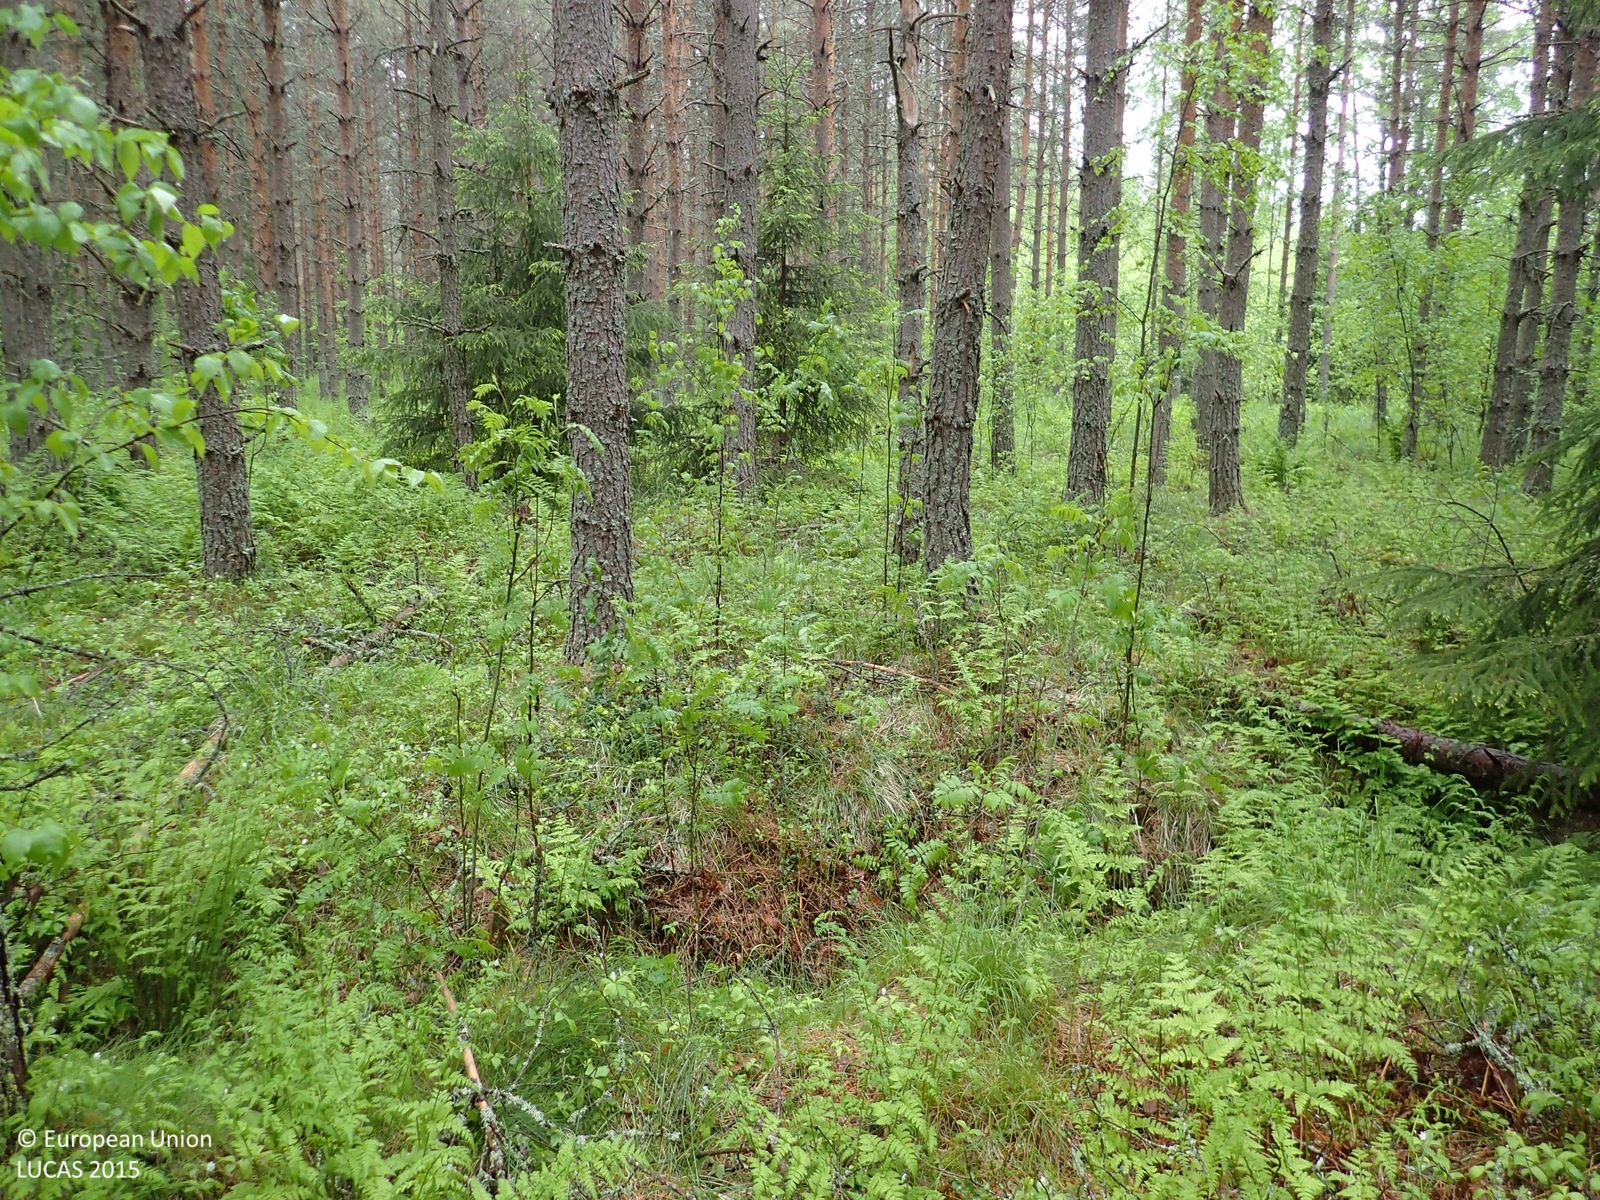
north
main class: Woodland
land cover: Pine dominated coniferous woodland
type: boreal forest
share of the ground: > 75 %
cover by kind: coniferous forest trees 70 %, herbaceous plants 25 %, broadleaved forest trees 5 %
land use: Forestry
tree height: > 5 m
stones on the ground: < 10 %
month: June
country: FI
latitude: 62.4615
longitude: 22.6405
